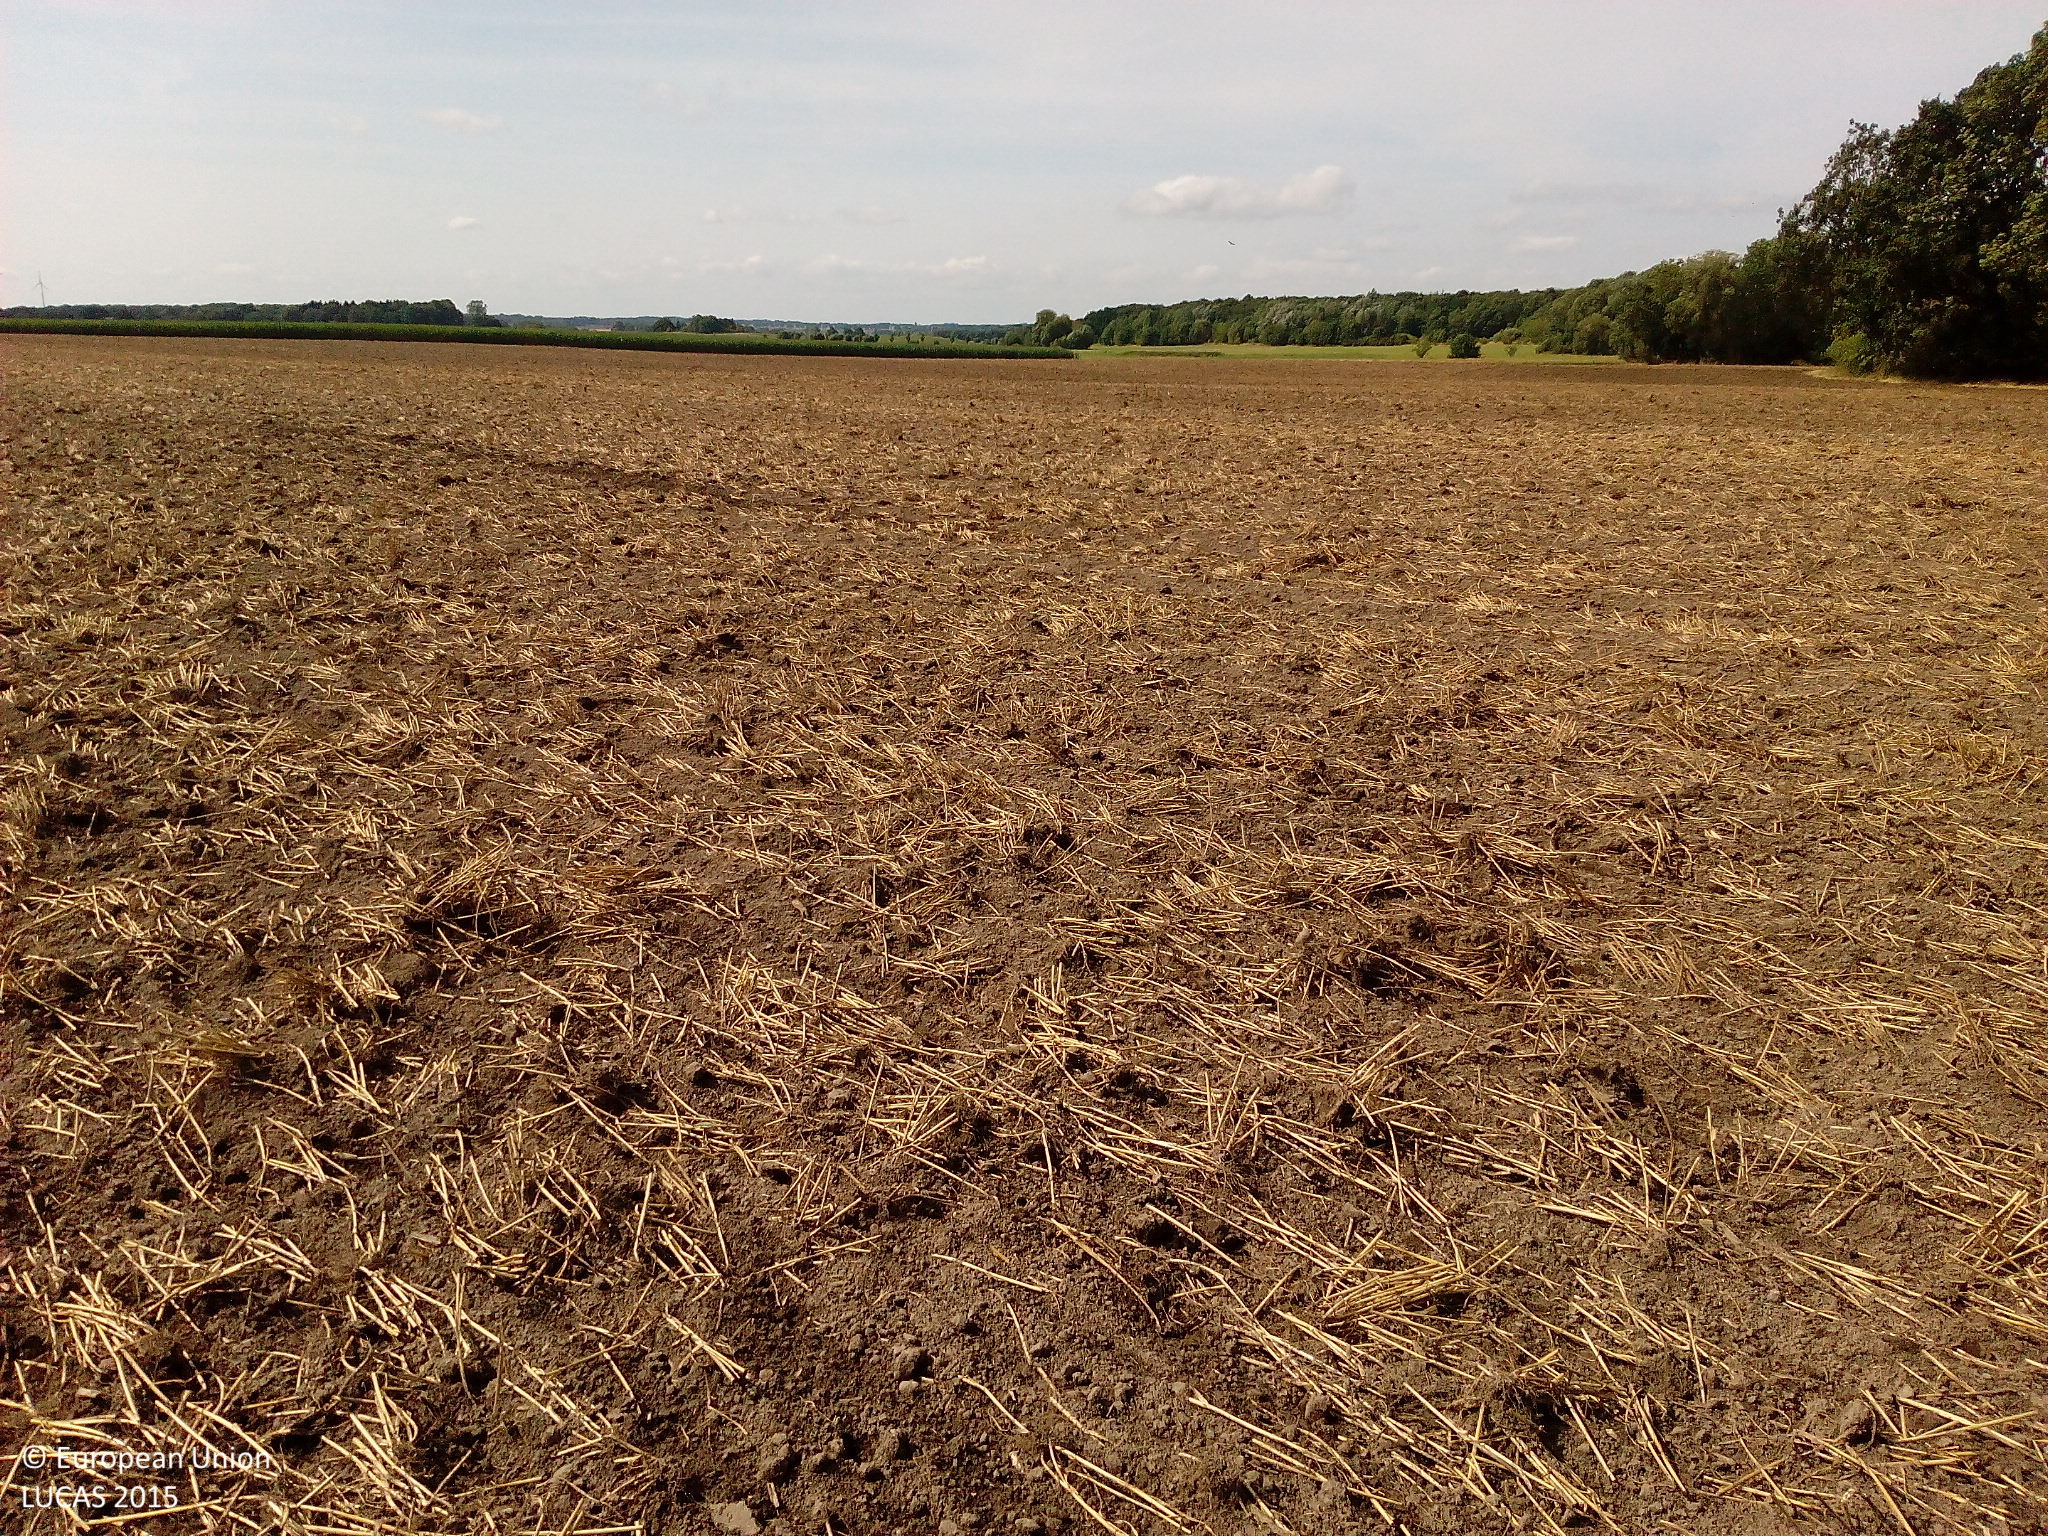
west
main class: Cropland
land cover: Common wheat
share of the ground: < 10 %
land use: Agriculture (excluding fallow land and kitchen gardens)
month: August
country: DE
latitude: 53.9487
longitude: 12.6351
